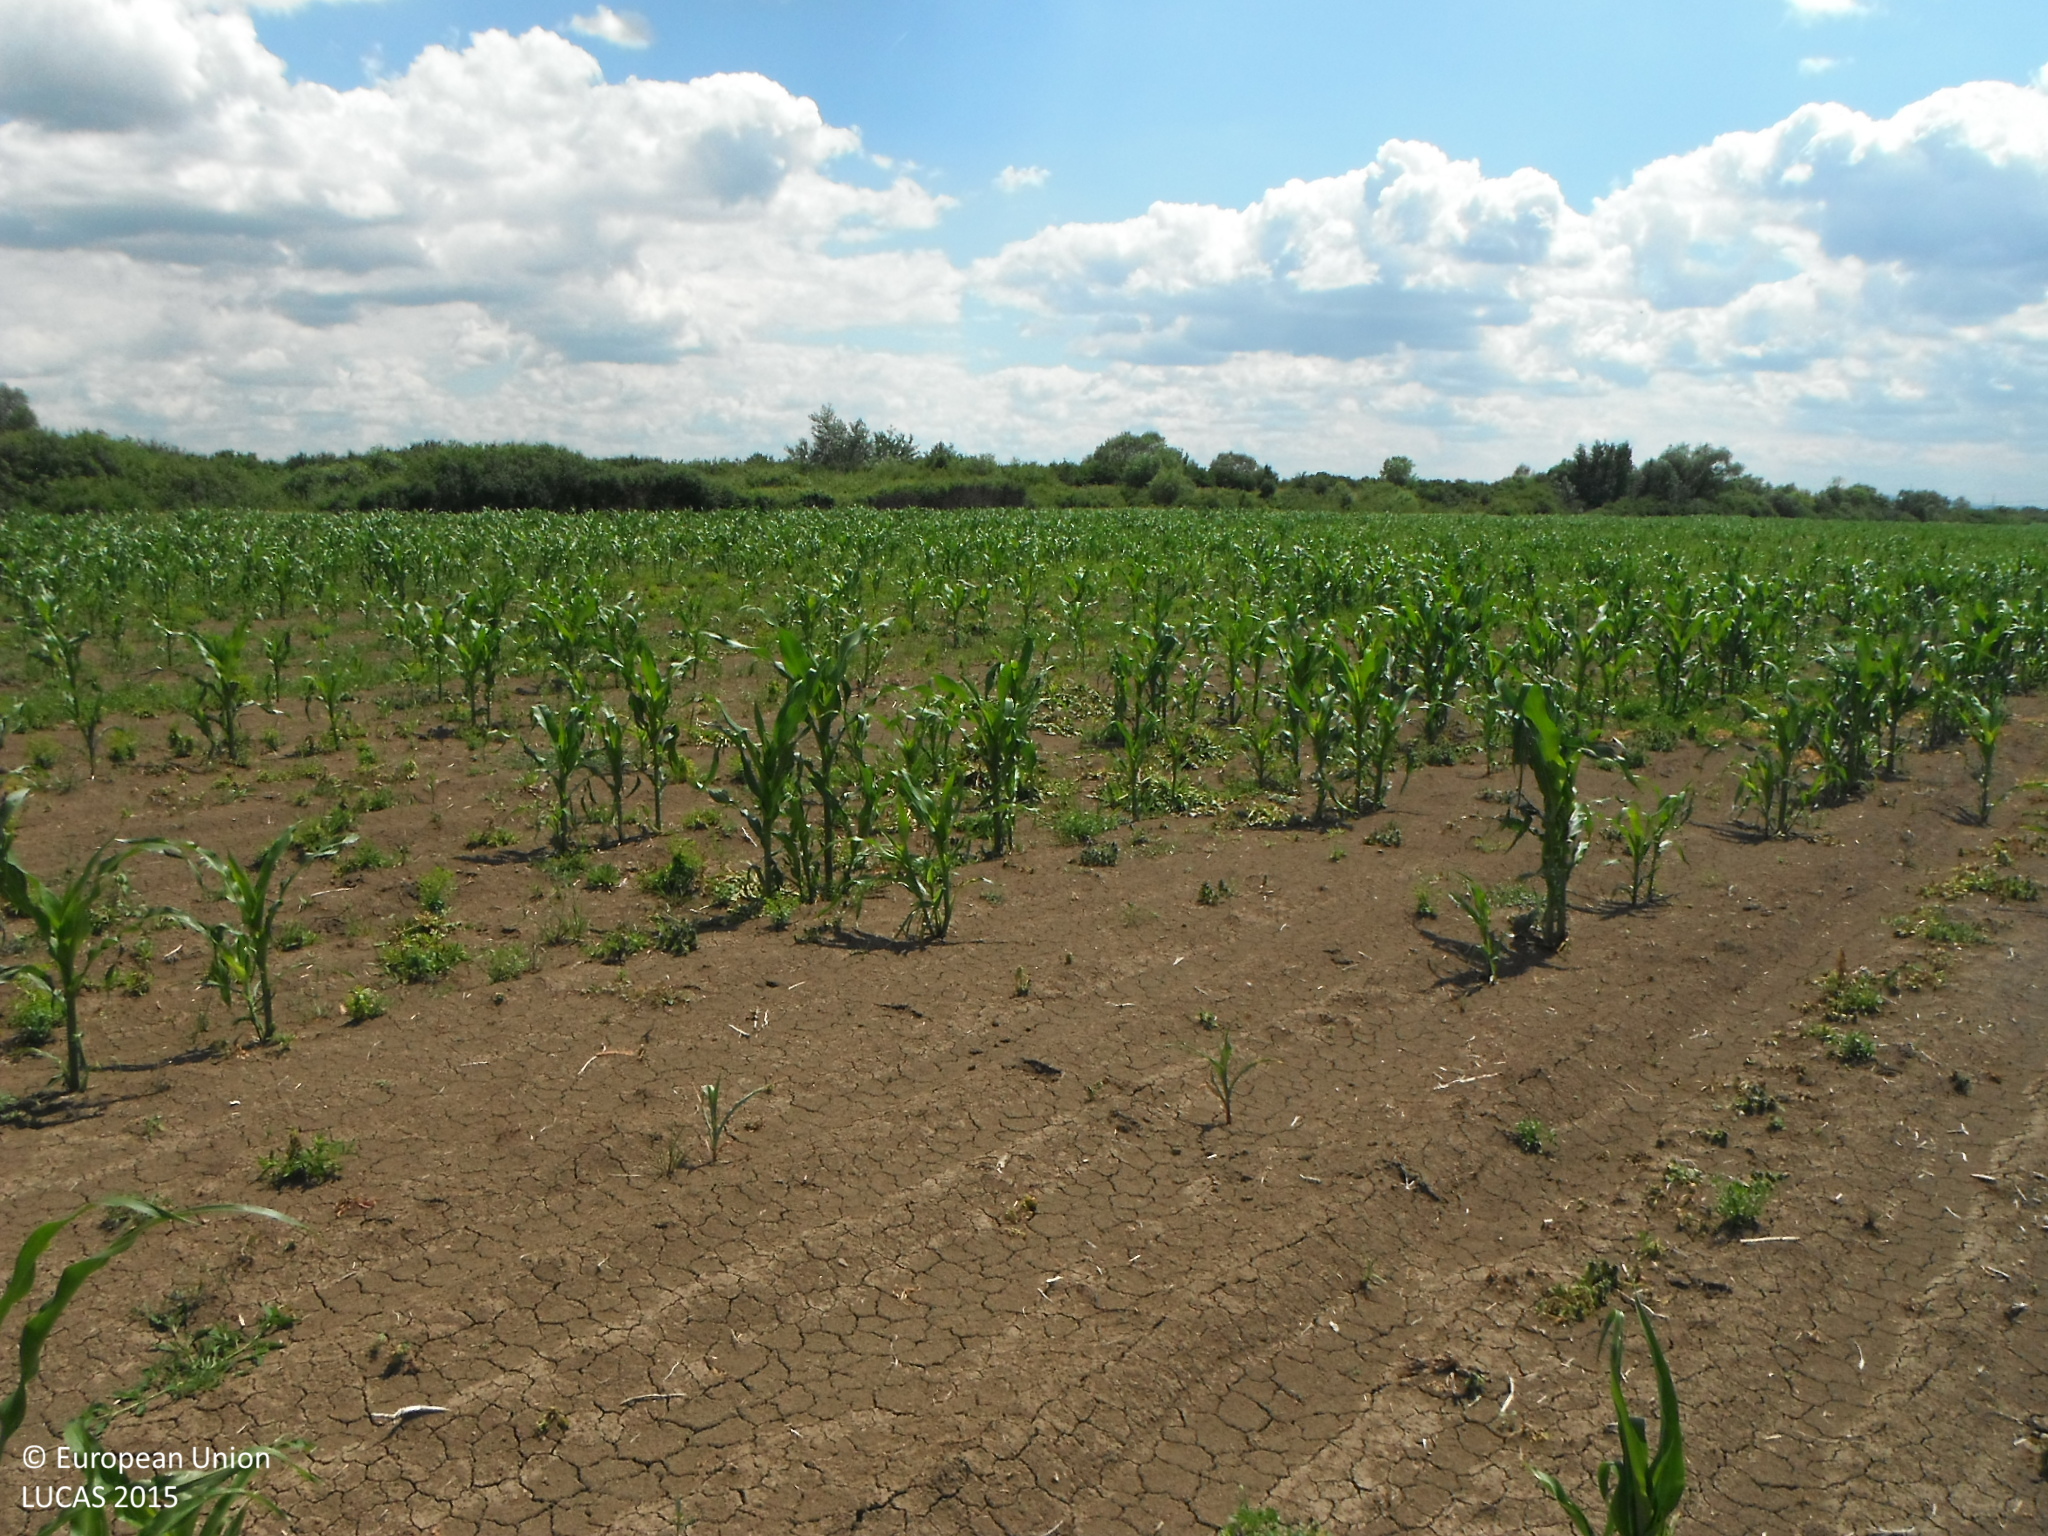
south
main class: Cropland
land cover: Maize
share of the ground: < 10 %
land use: Agriculture (excluding fallow land and kitchen gardens)
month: June
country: SK
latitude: 48.7079
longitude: 21.8619
